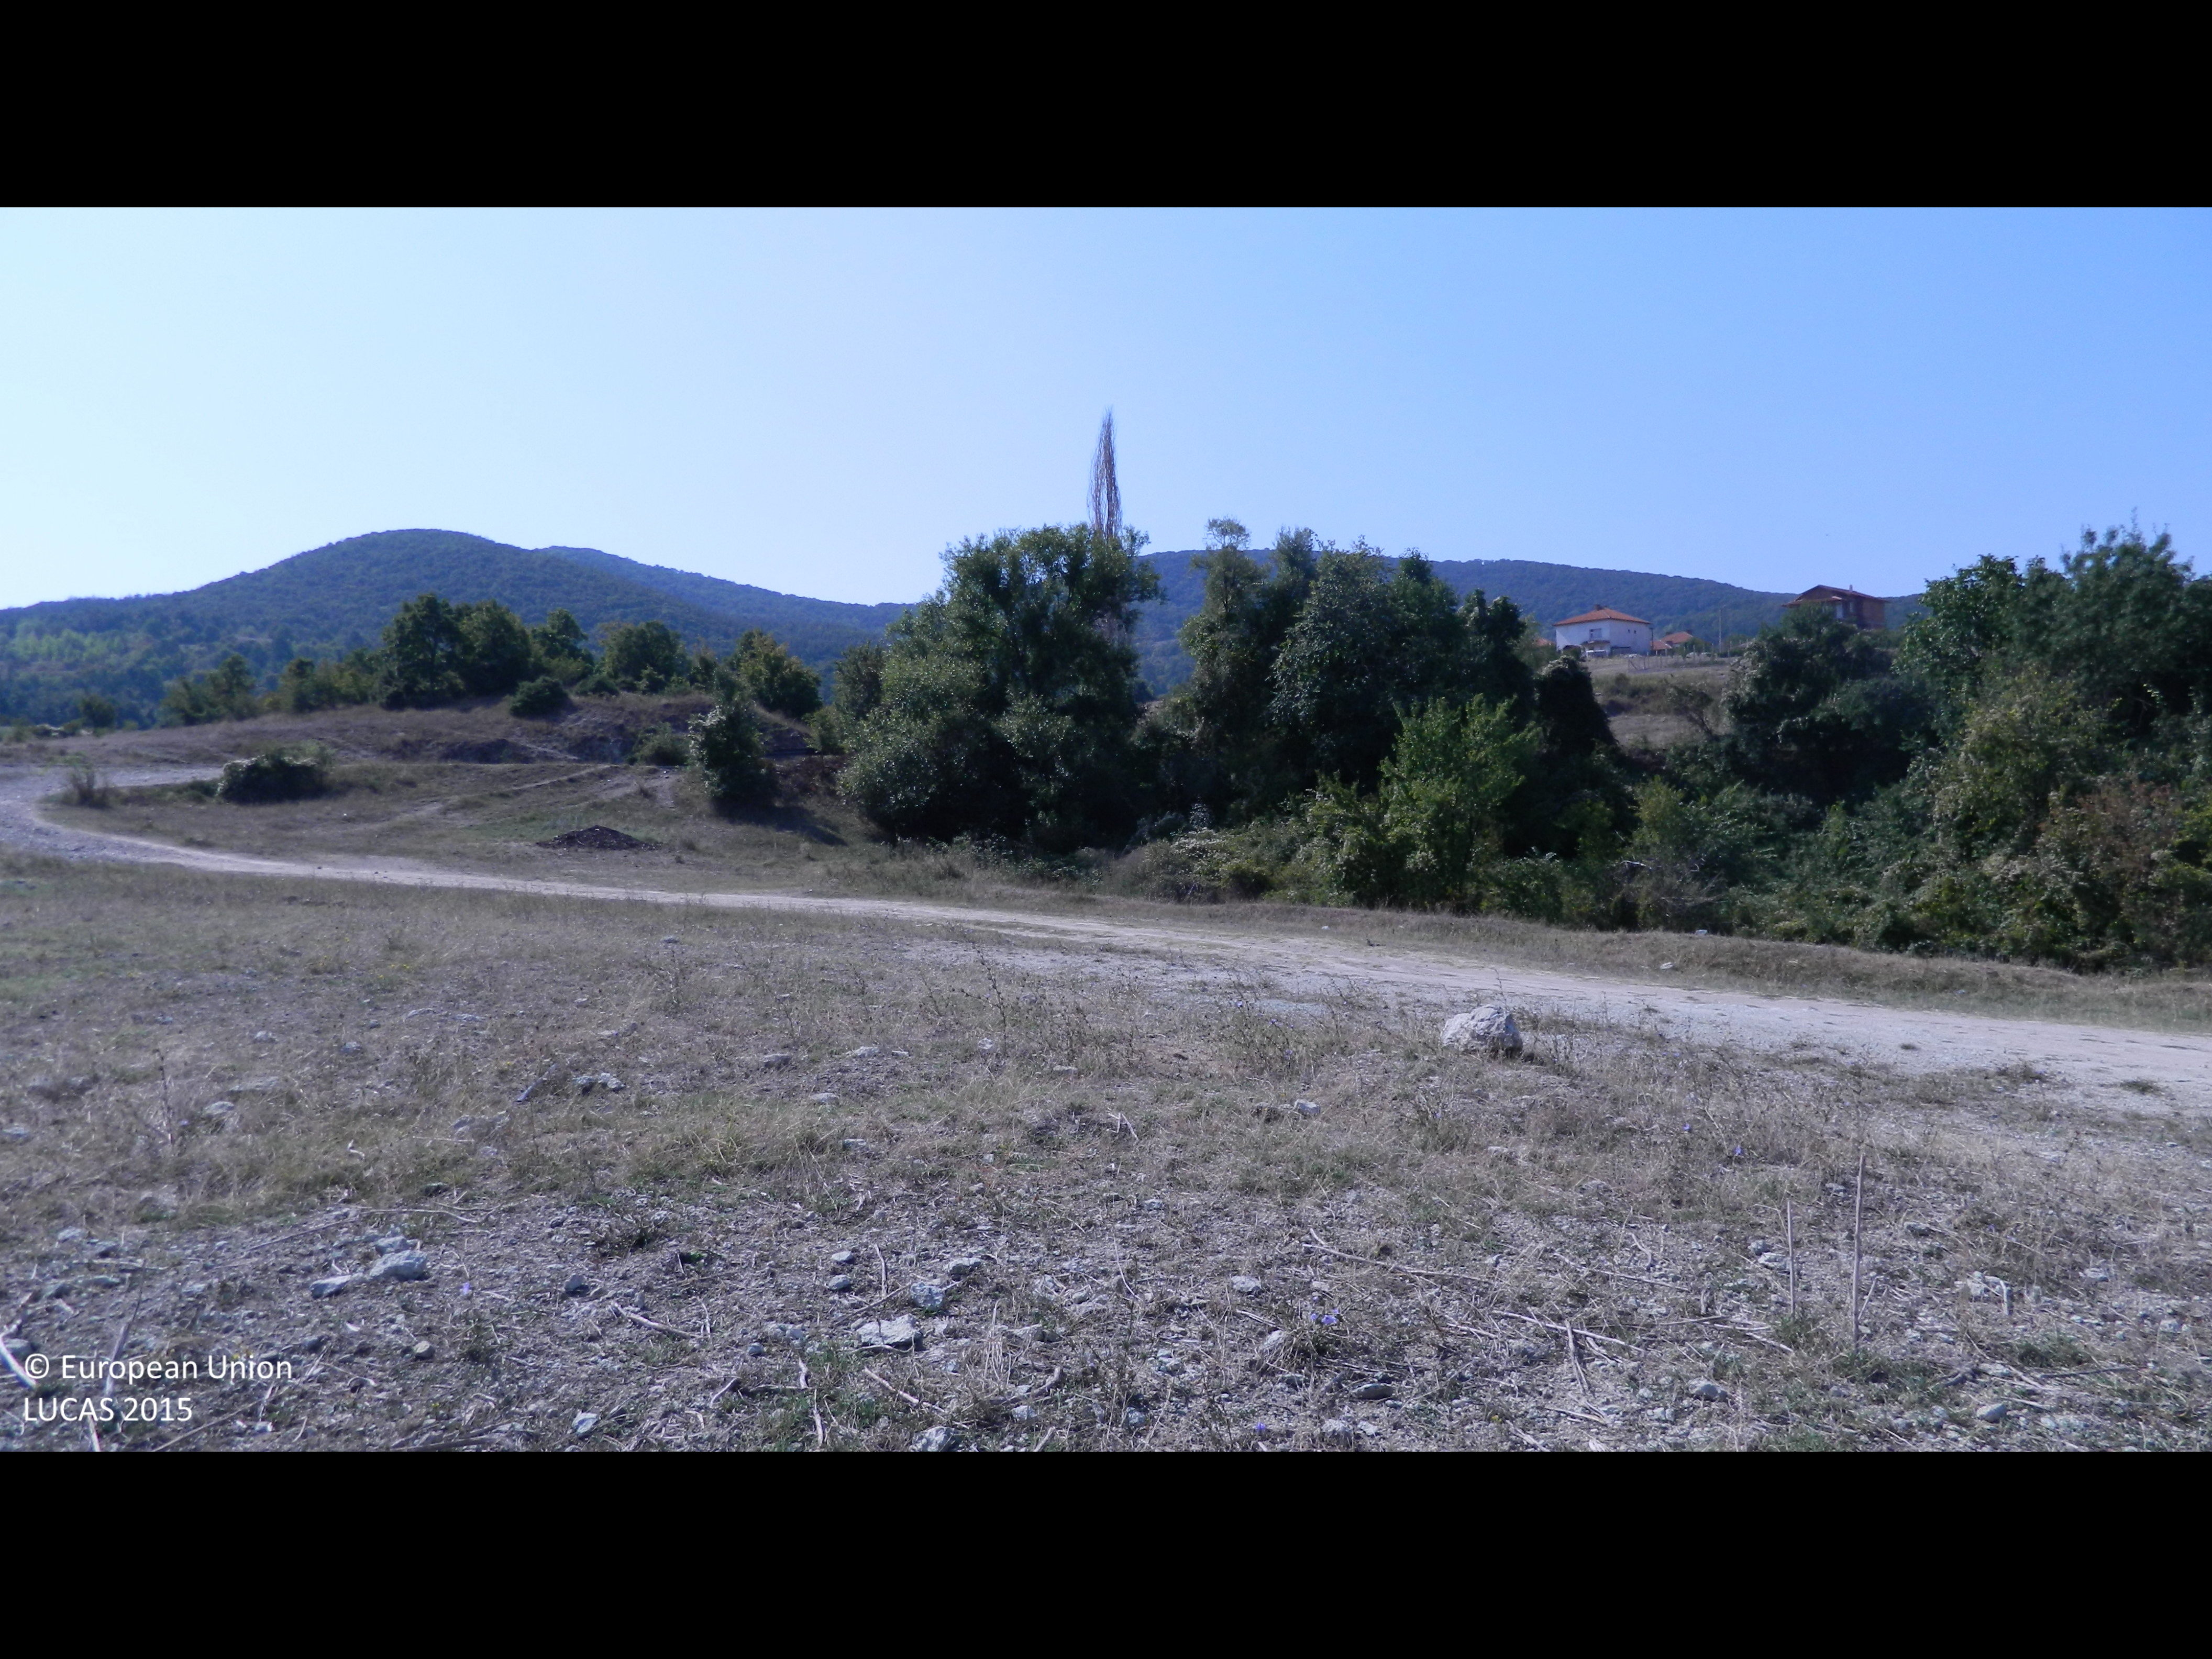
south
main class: Grassland
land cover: Spontaneously vegetated surfaces
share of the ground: 50 - 75 %
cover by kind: herbaceous plants 70 %, unconsolidated bare surface 30 %
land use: Agriculture (excluding fallow land and kitchen gardens)
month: September
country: BG
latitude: 41.7144
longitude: 25.7014
